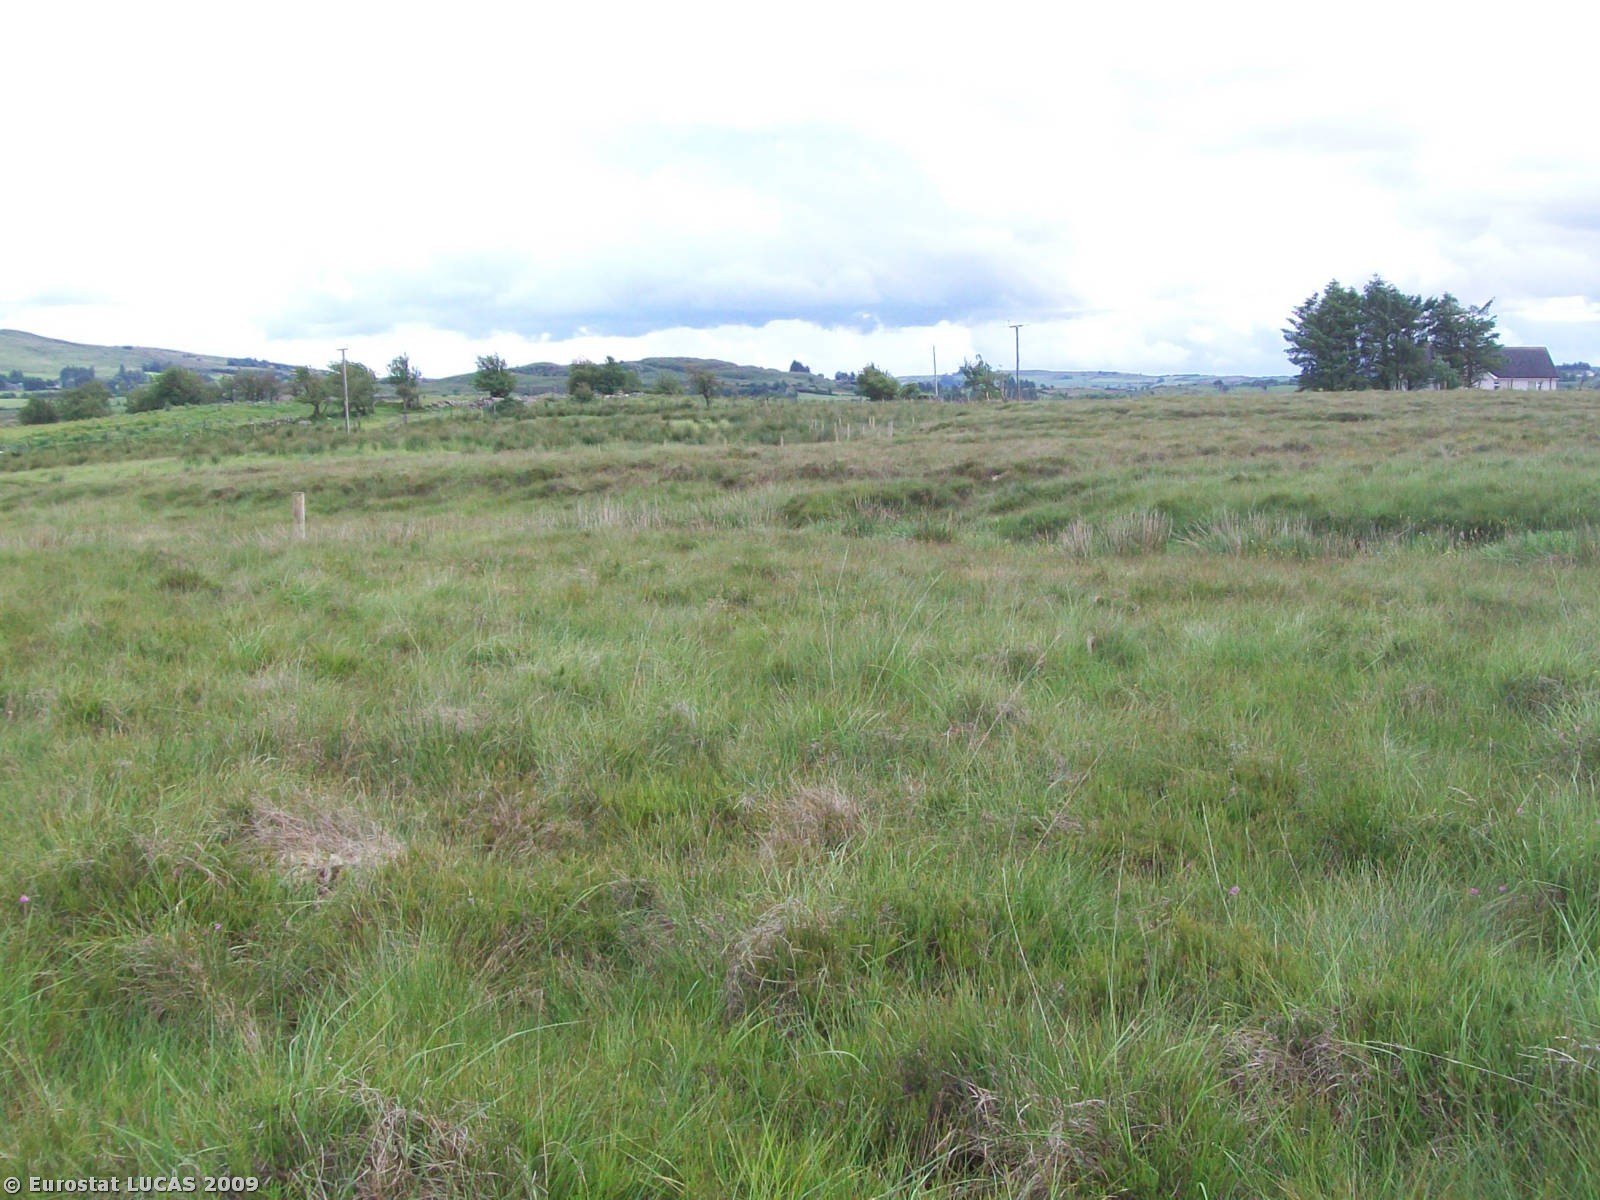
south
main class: Wetlands
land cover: Peatbogs
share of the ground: > 75 %
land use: Unused
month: July
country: GB
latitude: 54.7159
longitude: -6.9491
